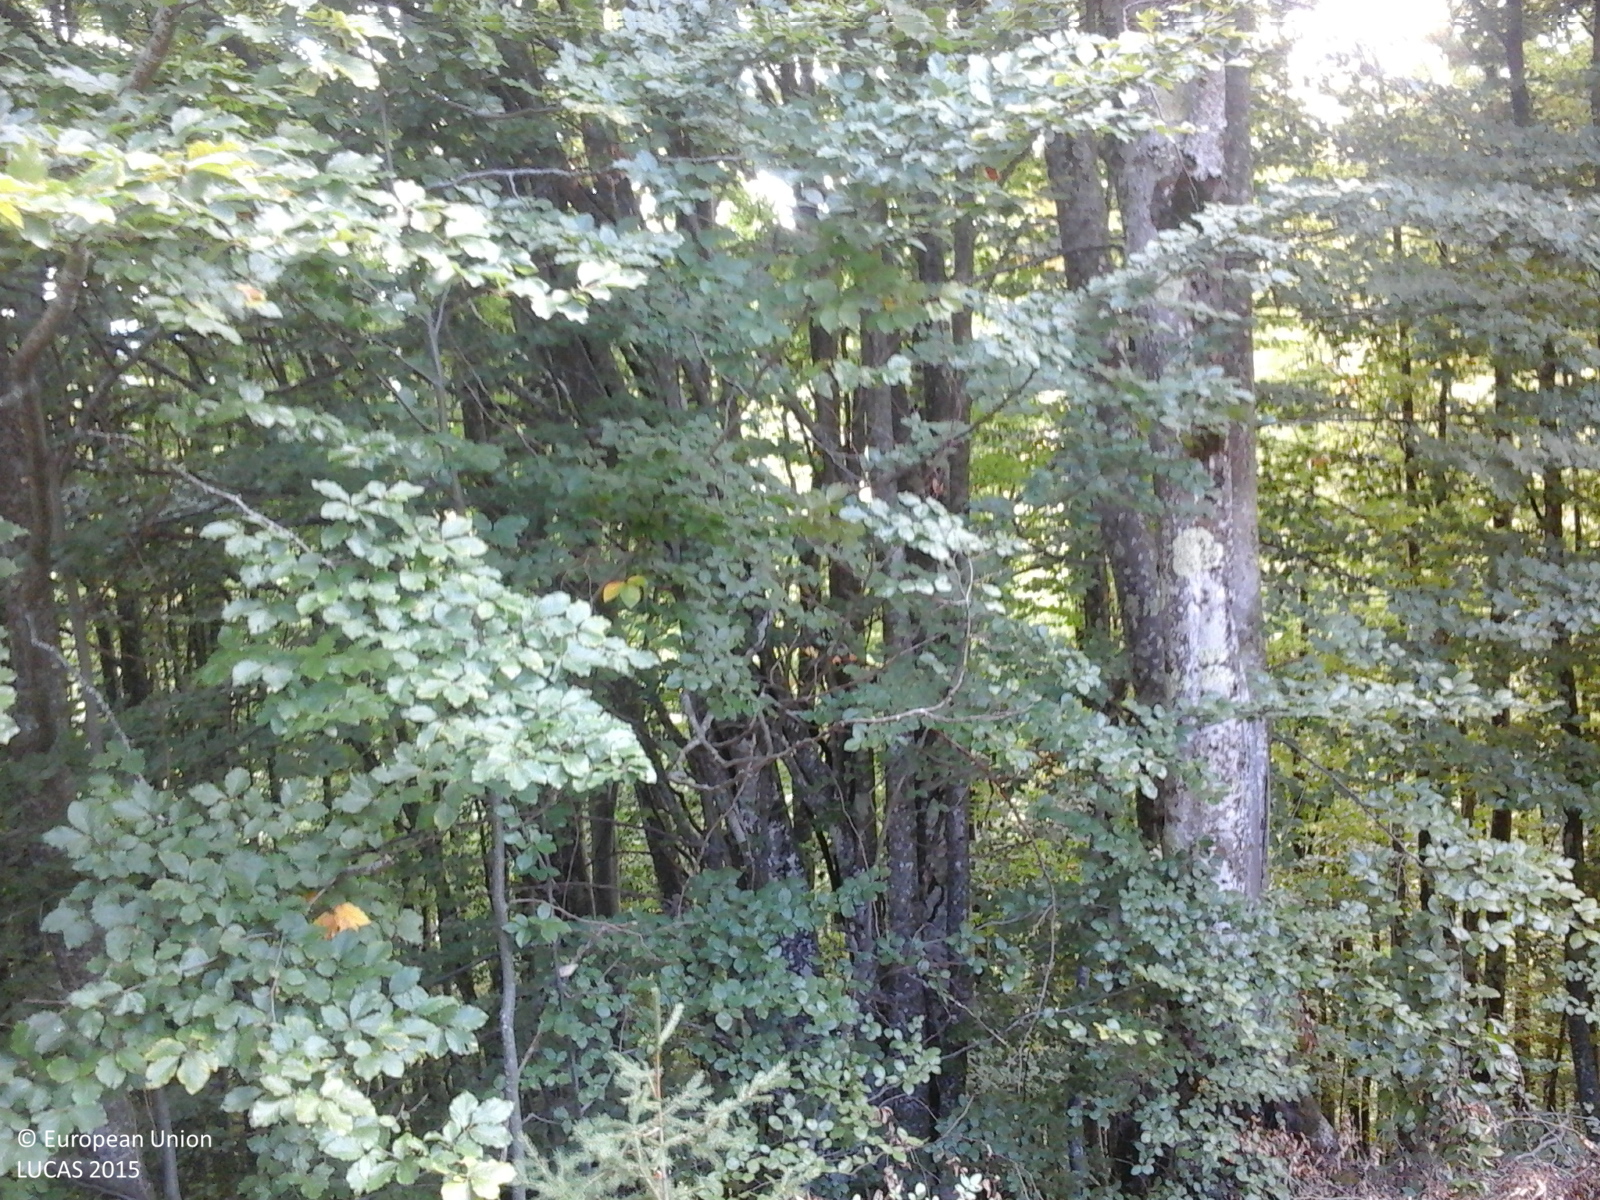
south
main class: Woodland
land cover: Broadleaved woodland
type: mesophytic deciduous forest
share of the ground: > 75 %
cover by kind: broadleaved forest trees 100 %
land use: Forestry
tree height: > 5 m
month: October
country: RO
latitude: 46.3876
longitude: 22.8913
